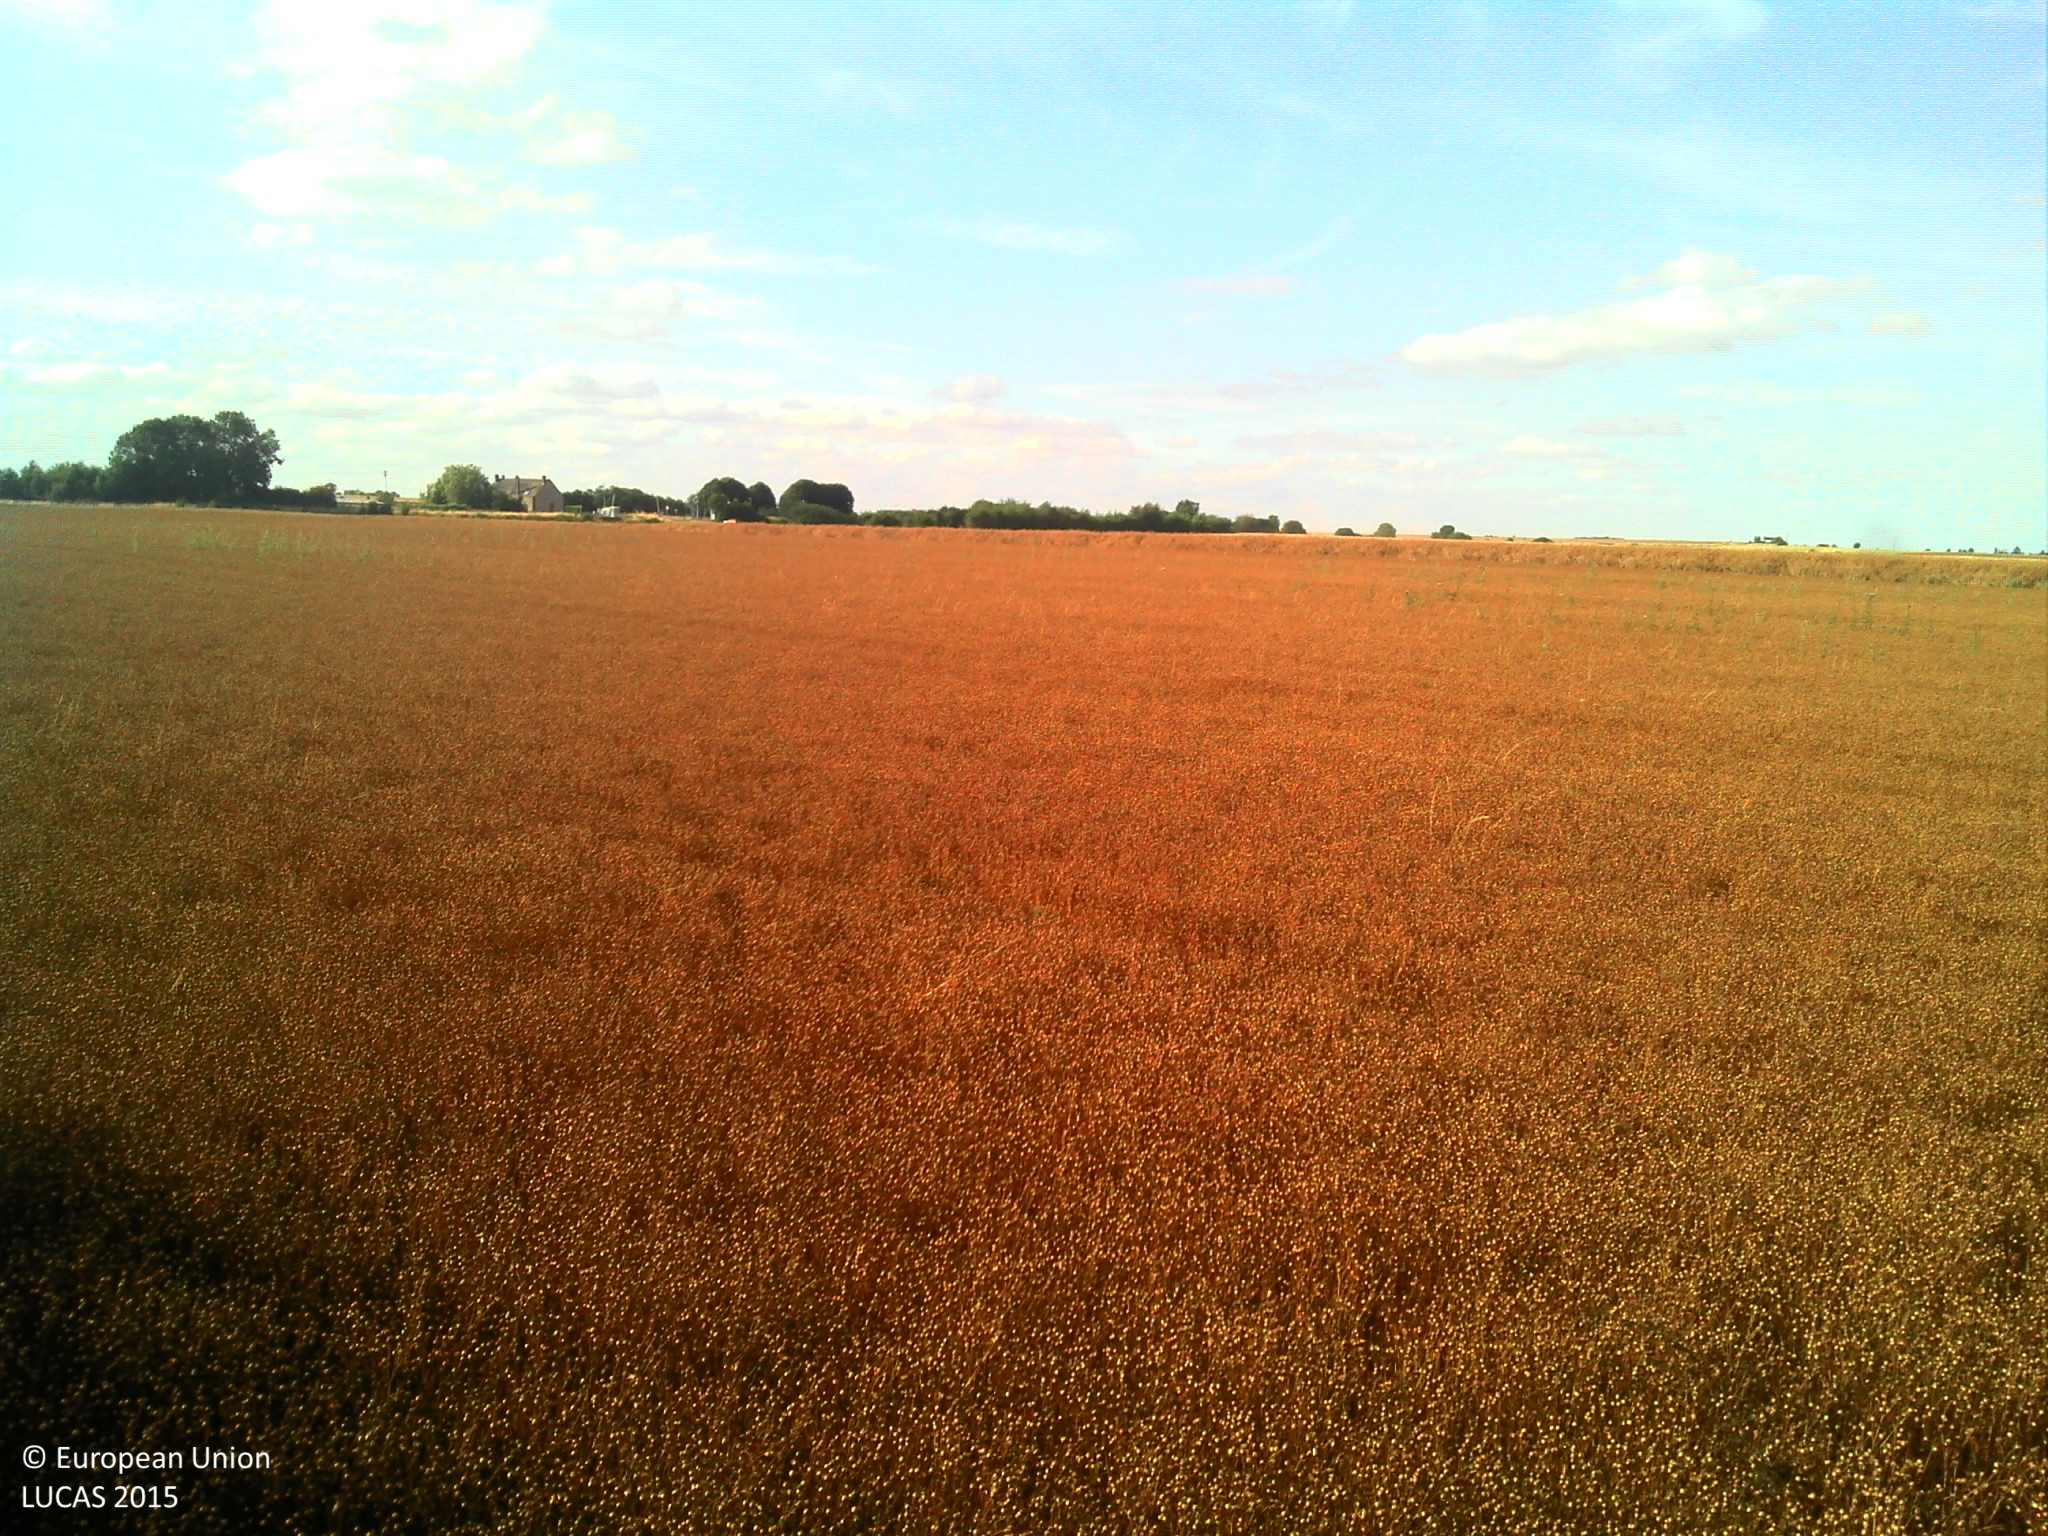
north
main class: Cropland
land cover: Rape and turnip rape
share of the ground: > 75 %
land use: Agriculture (excluding fallow land and kitchen gardens)
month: July
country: FR
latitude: 48.3301
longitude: 1.2818
